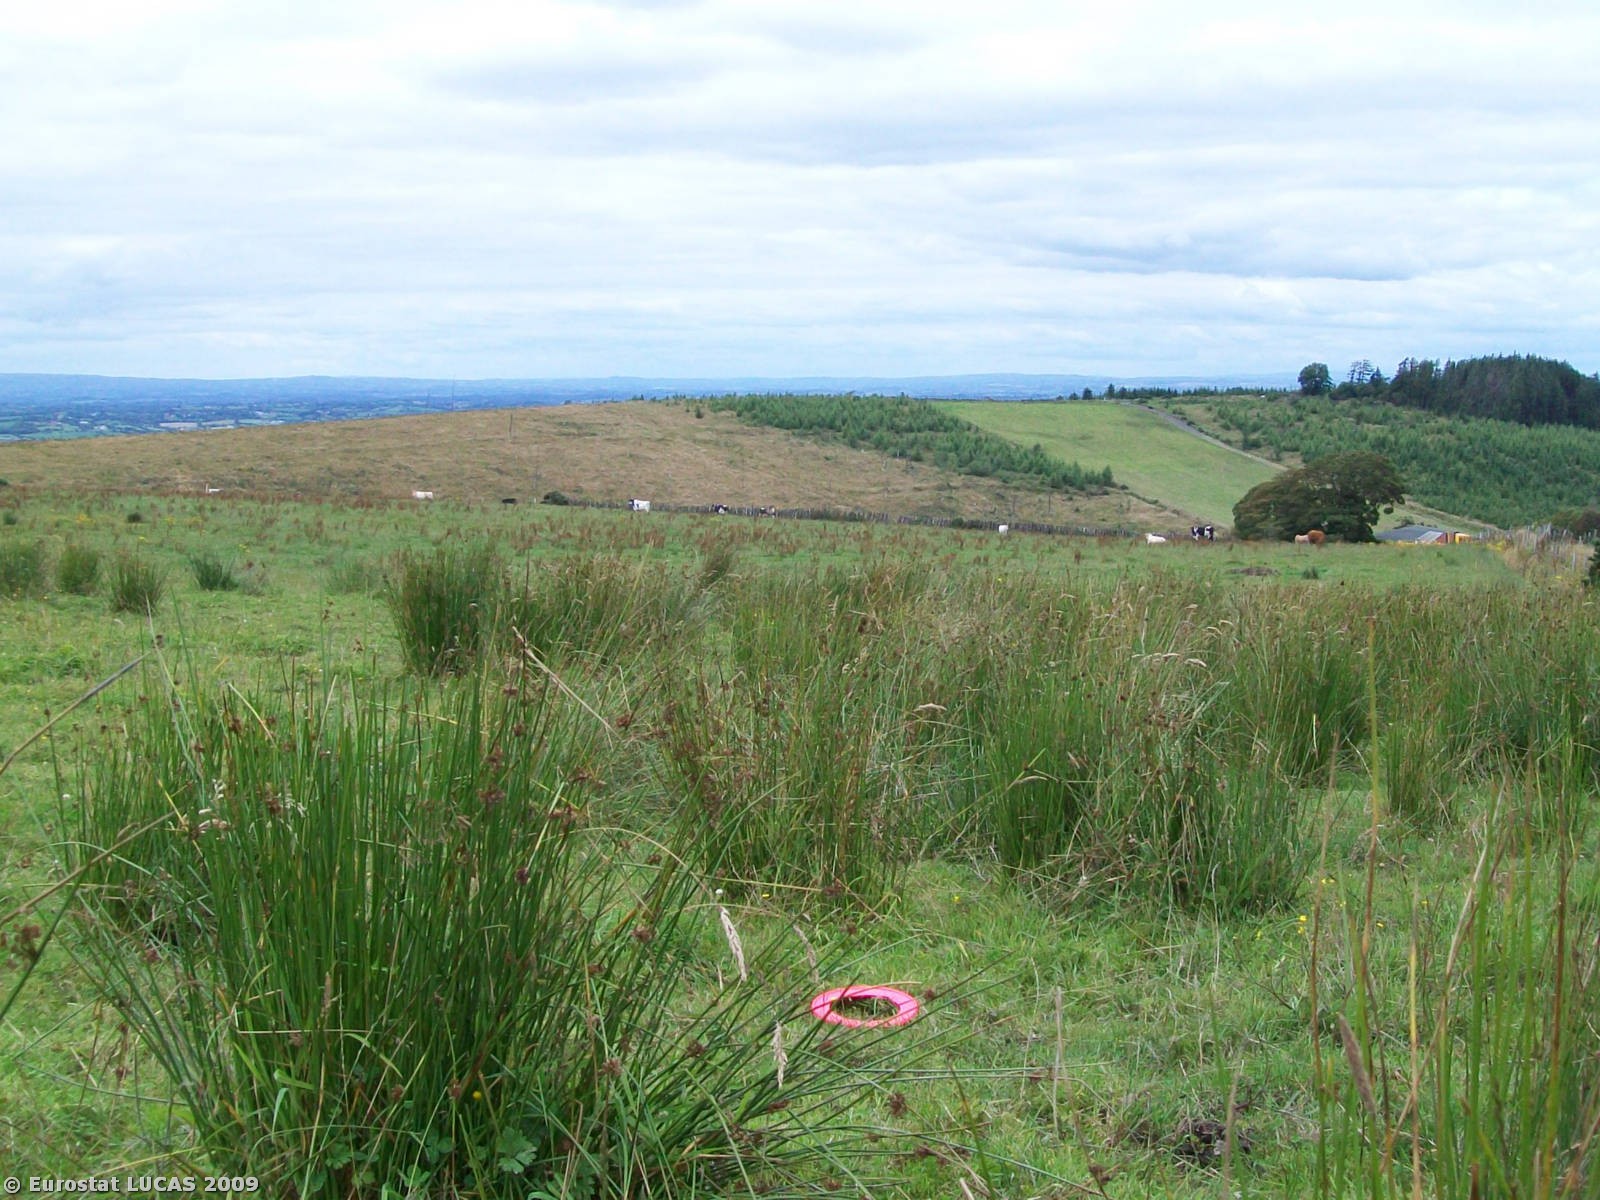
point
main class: Grassland
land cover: Grassland without tree/shrub cover
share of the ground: > 75 %
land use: Agriculture (excluding fallow land and kitchen gardens)
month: August
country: GB
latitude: 54.2491
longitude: -6.5957
